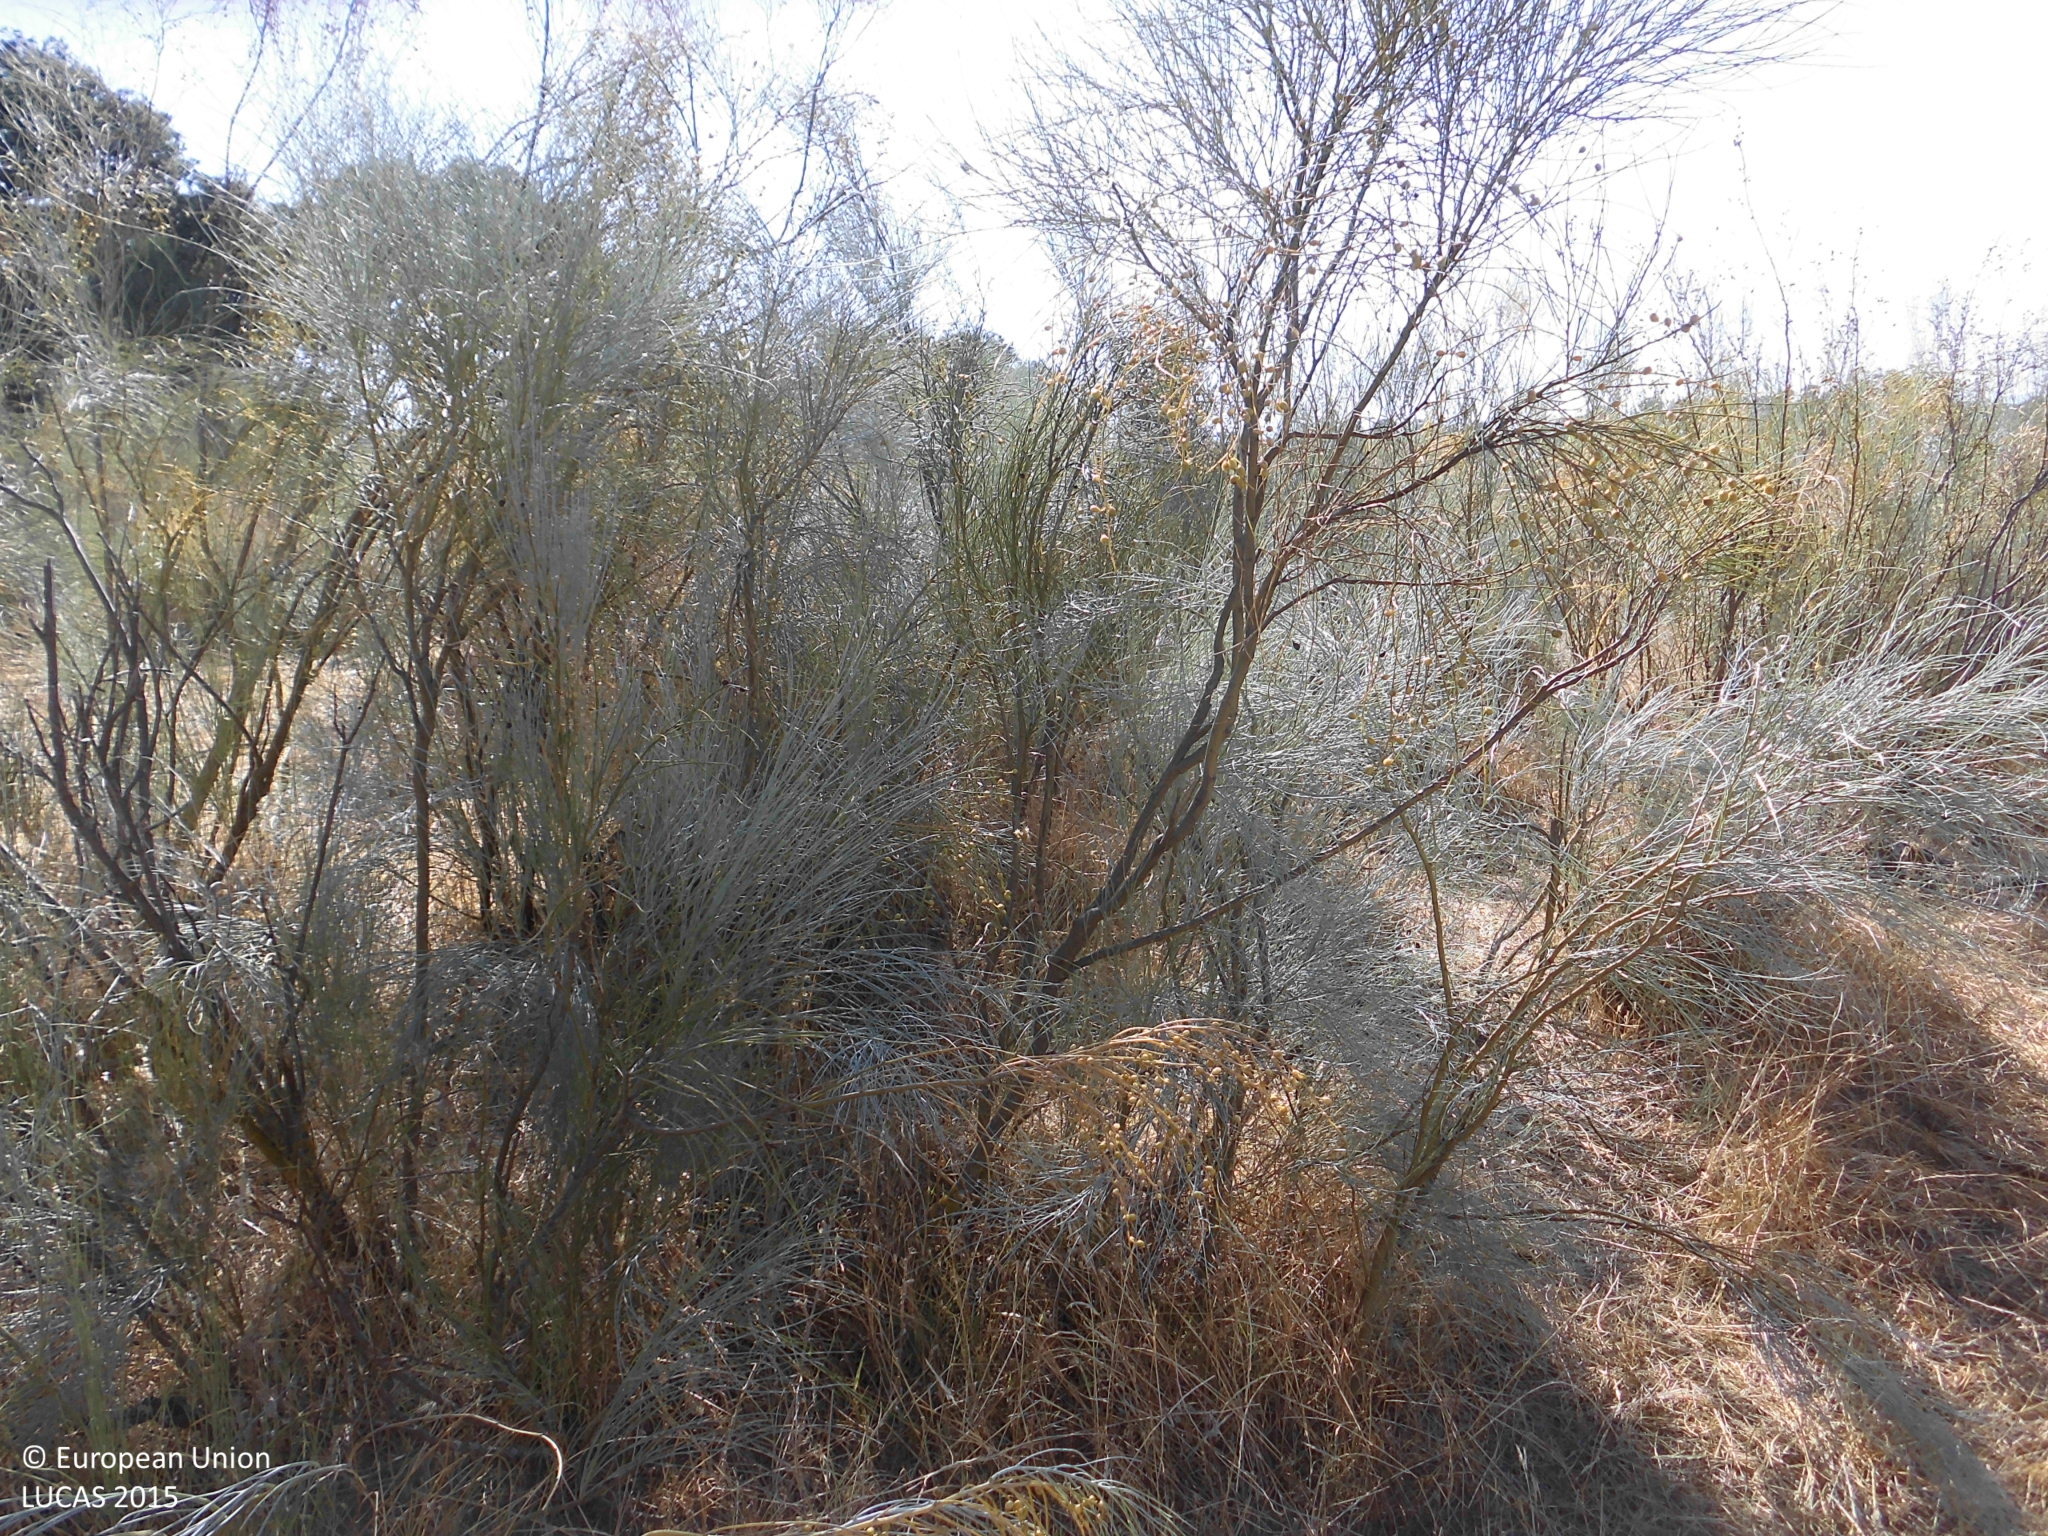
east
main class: Woodland
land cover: Broadleaved woodland
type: broadleaved evergreen forest
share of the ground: 10 - 25 %
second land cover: Shrubland without tree cover
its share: 50 - 75 %
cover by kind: shrubs 50 %, herbaceous plants 40 %, broadleaved forest trees 10 %
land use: Forestry
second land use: Agriculture (excluding fallow land and kitchen gardens)
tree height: > 5 m
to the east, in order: Broadleaved woodland; Shrubland without tree cover; Tracks; Broadleaved woodland; Abandoned hedges; Rivers and streams; Broadleaved woodland; Electric lines; Shrubland with sparse tree cover
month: July
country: ES
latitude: 40.0750
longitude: -6.1738
